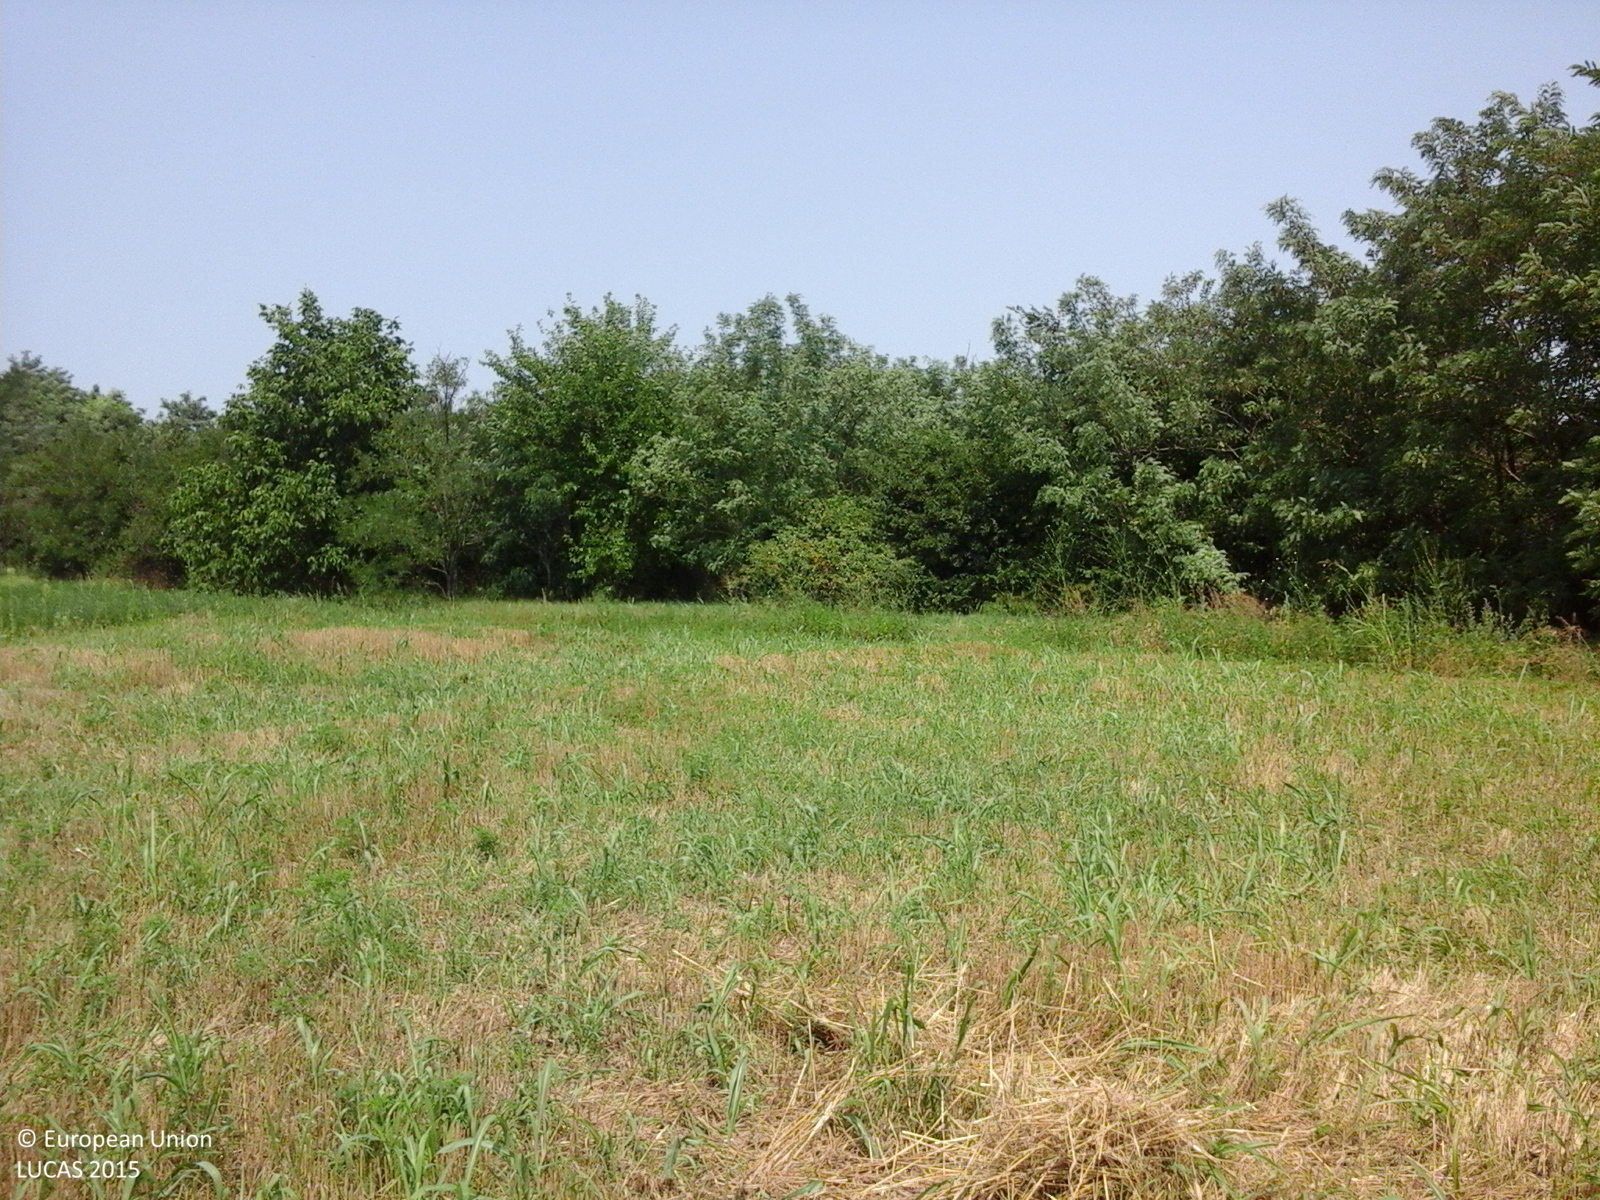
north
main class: Cropland
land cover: Common wheat
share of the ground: < 10 %
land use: Agriculture (excluding fallow land and kitchen gardens)
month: July
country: RO
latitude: 44.6928
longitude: 26.7168
